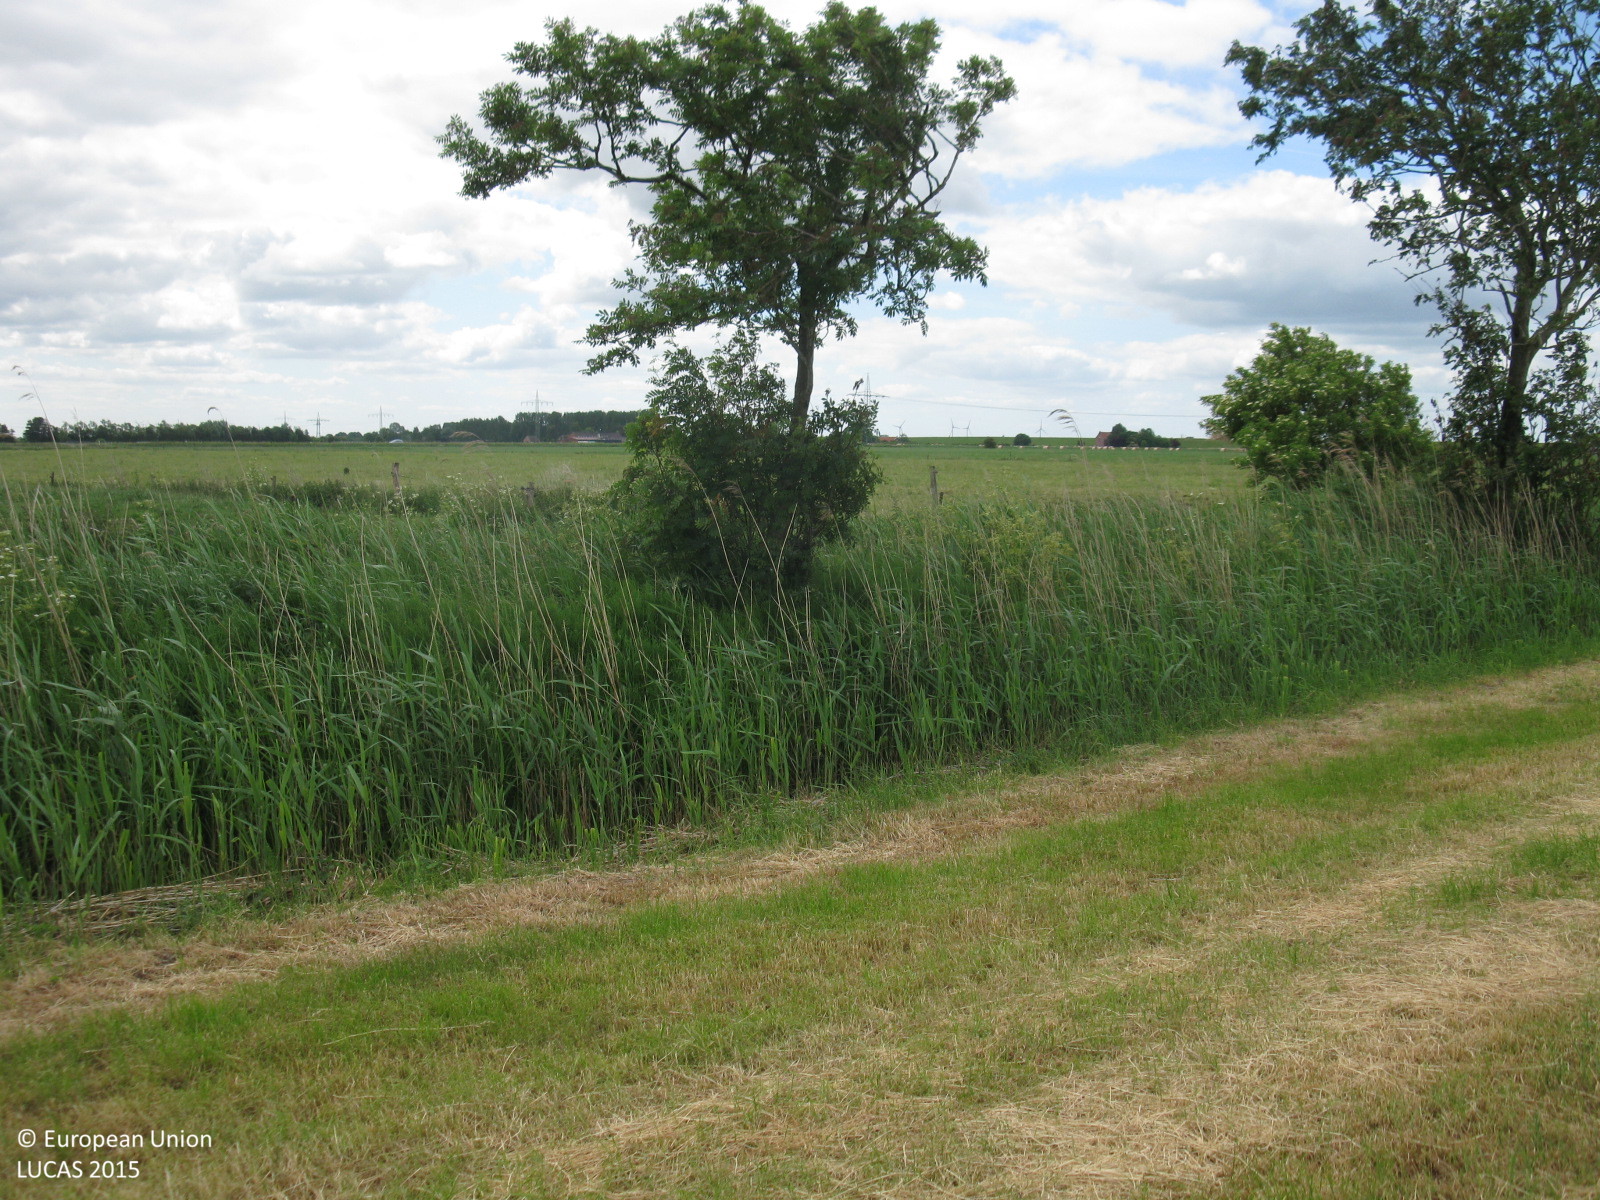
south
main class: Grassland
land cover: Grassland without tree/shrub cover
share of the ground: > 75 %
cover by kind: herbaceous plants 100 %
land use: Agriculture (excluding fallow land and kitchen gardens)
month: June
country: DE
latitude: 53.3022
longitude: 7.4046
